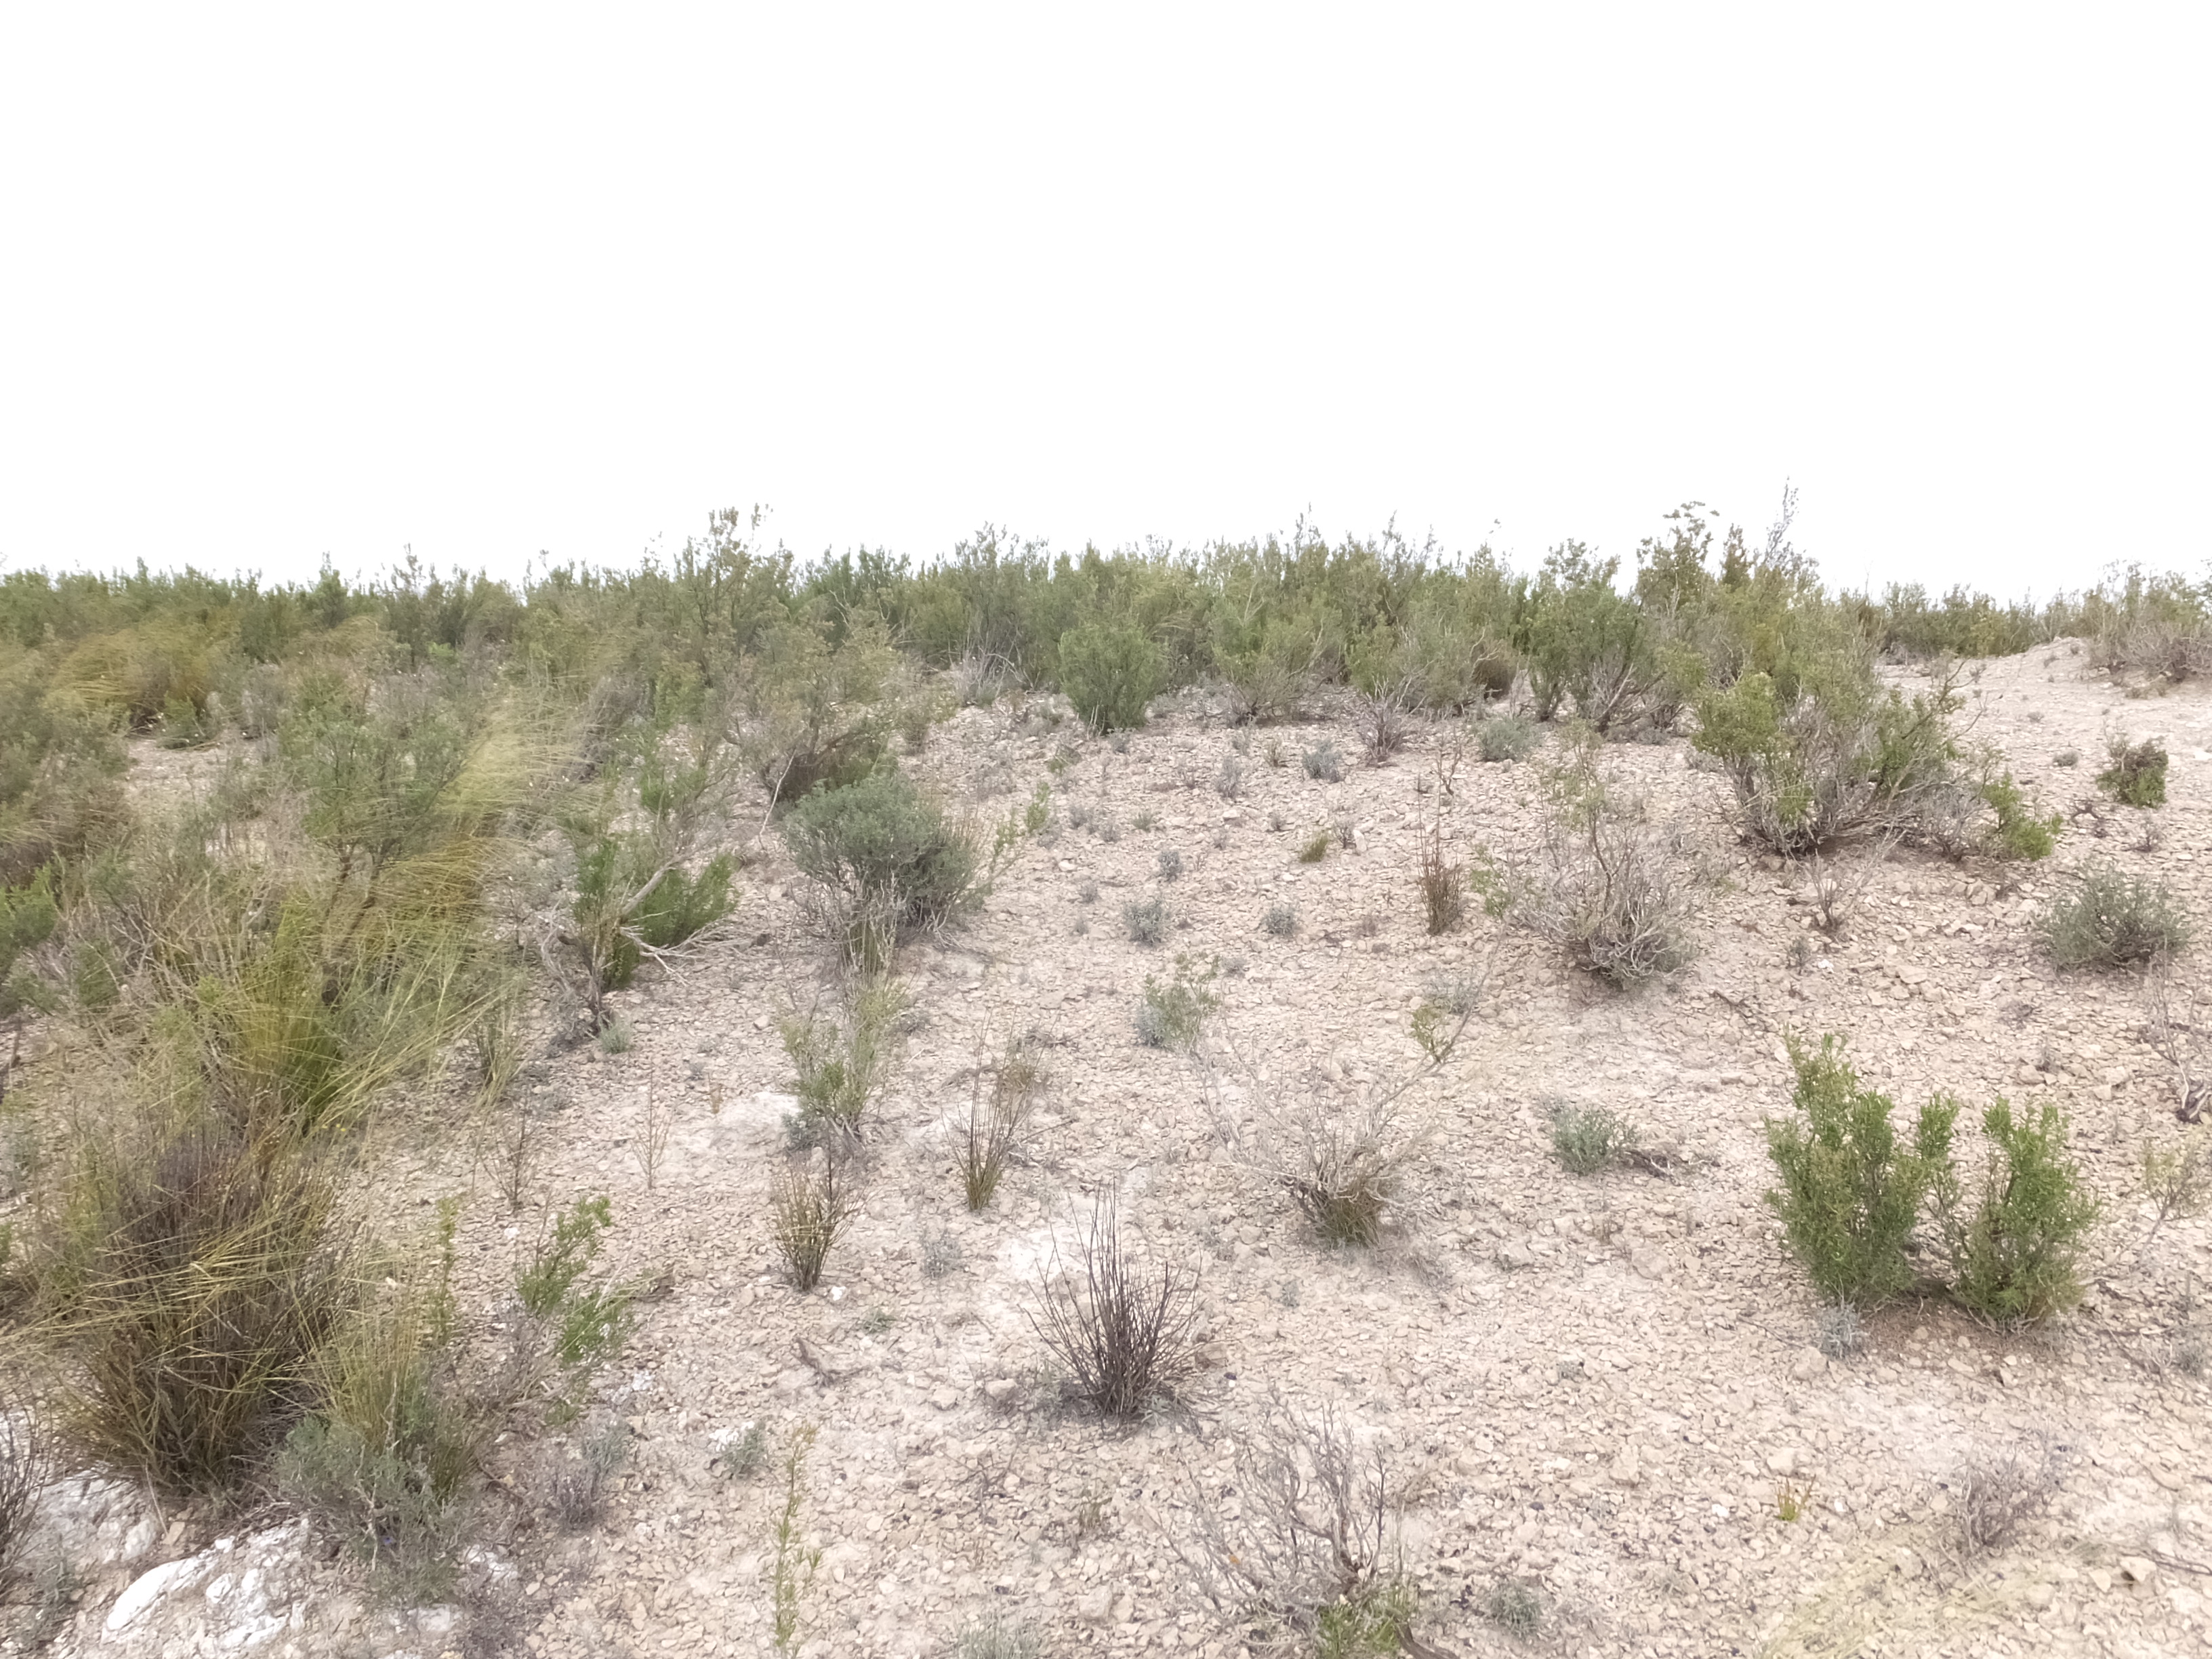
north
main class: Shrubland
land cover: Shrubland without tree cover
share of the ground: 25 - 50 %
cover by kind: shrubs 40 %, consolidated bare surface 35 %, herbaceous plants 25 %
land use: Semi-natural and natural areas not in use
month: May
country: ES
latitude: 41.4852
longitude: -0.3525
